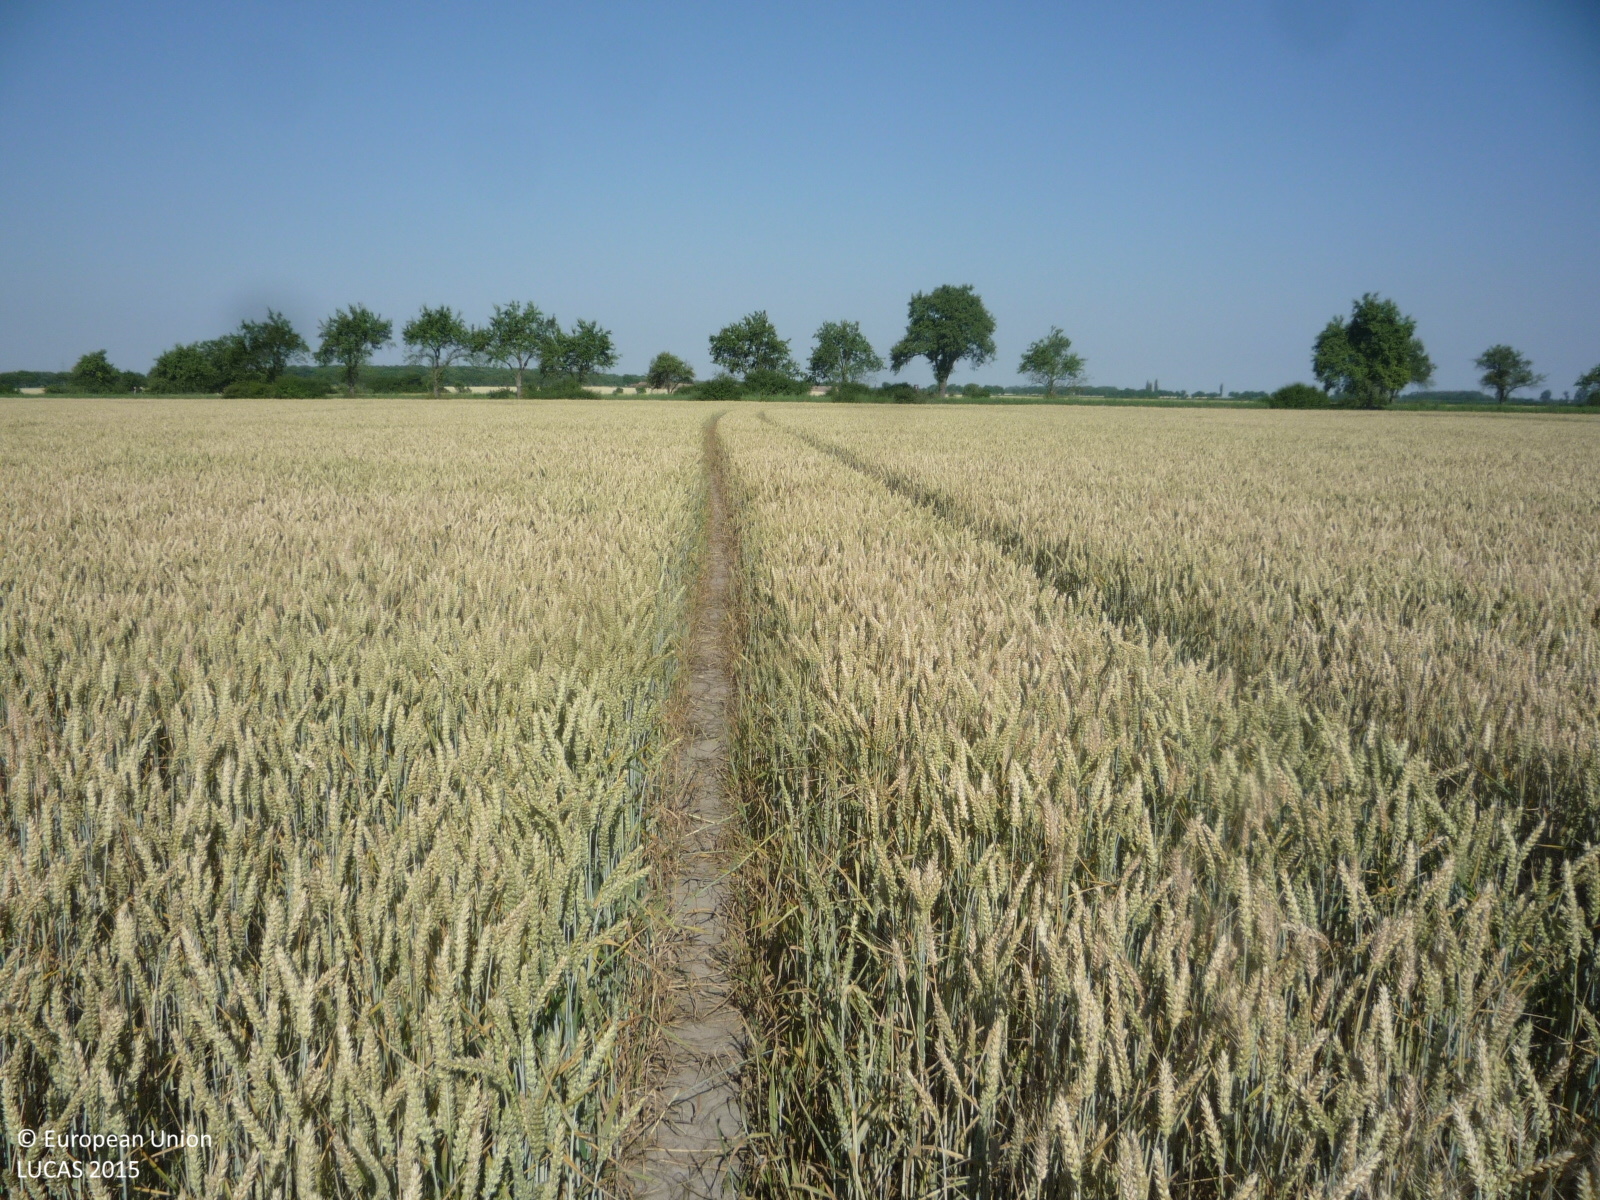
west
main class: Cropland
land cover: Common wheat
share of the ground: > 75 %
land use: Agriculture (excluding fallow land and kitchen gardens)
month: July
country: CZ
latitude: 50.1751
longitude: 15.1700
